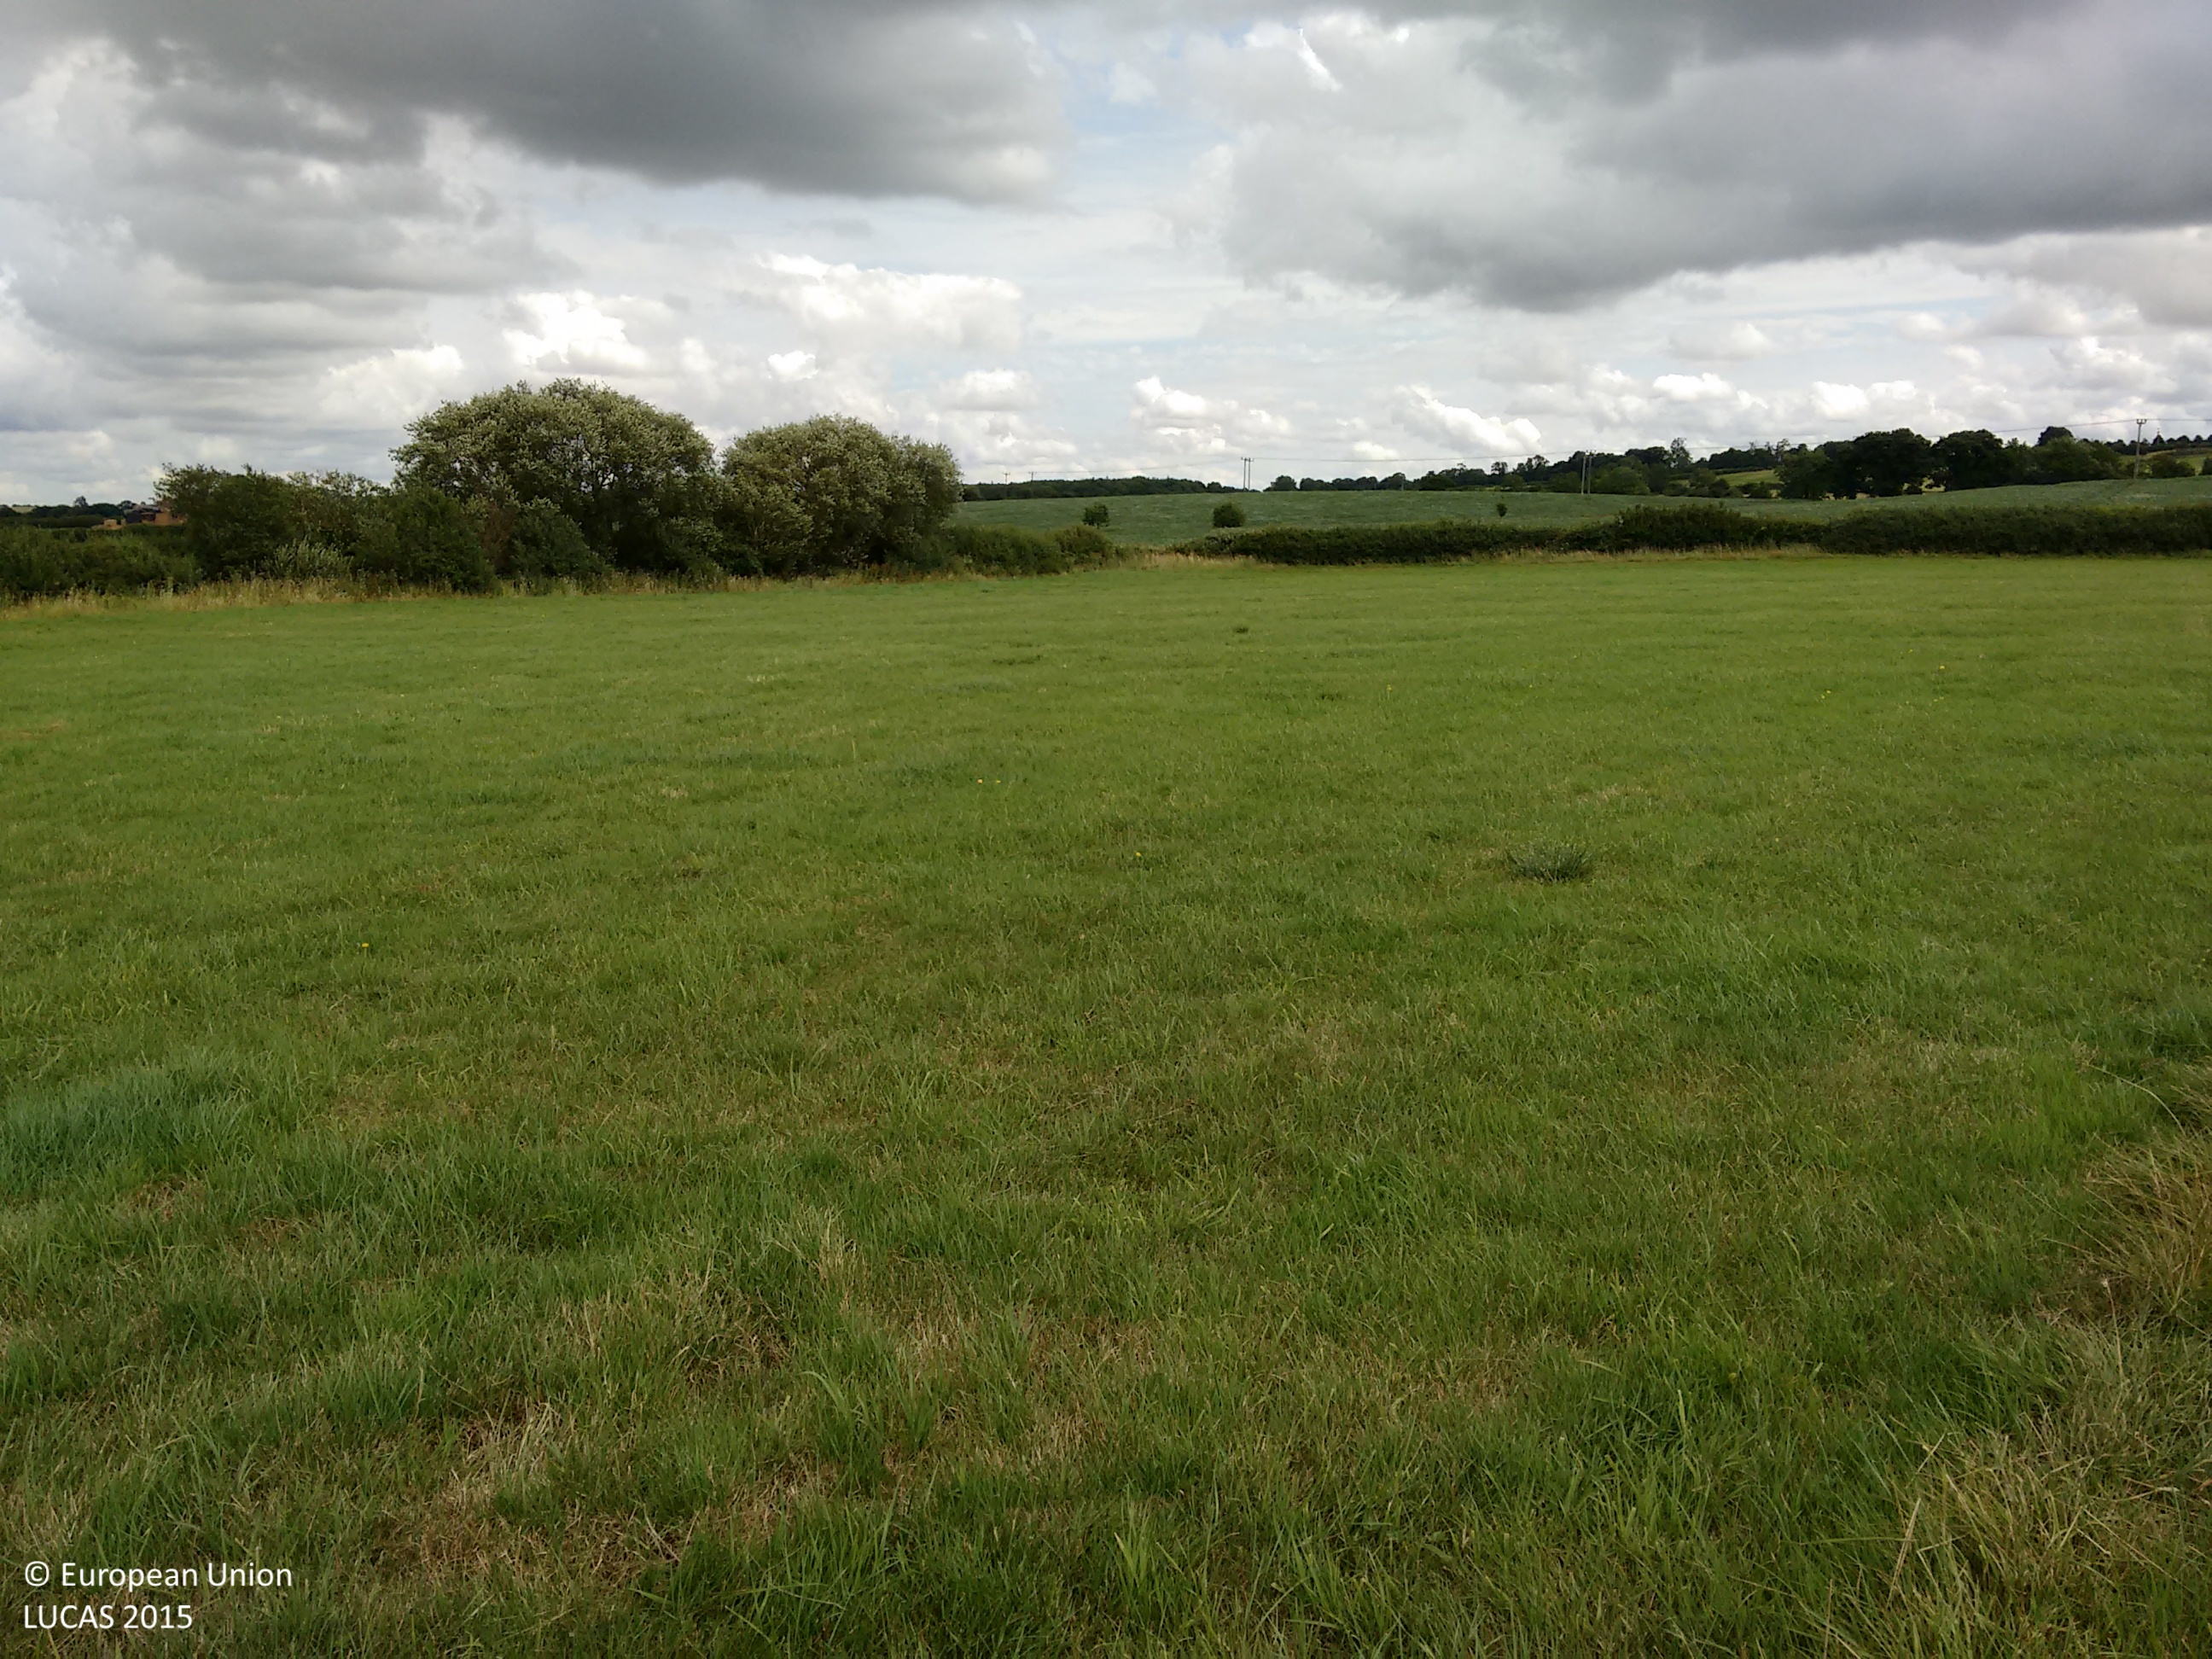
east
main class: Grassland
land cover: Grassland without tree/shrub cover
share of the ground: > 75 %
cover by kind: herbaceous plants 100 %
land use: Agriculture (excluding fallow land and kitchen gardens)
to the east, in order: Grassland without tree/shrub cover; Fences; Managed hedges; Ditches and canals; Grass margins; Dry pulses; Grass margins; Tracks
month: July
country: GB
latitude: 52.6899
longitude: -0.7074
